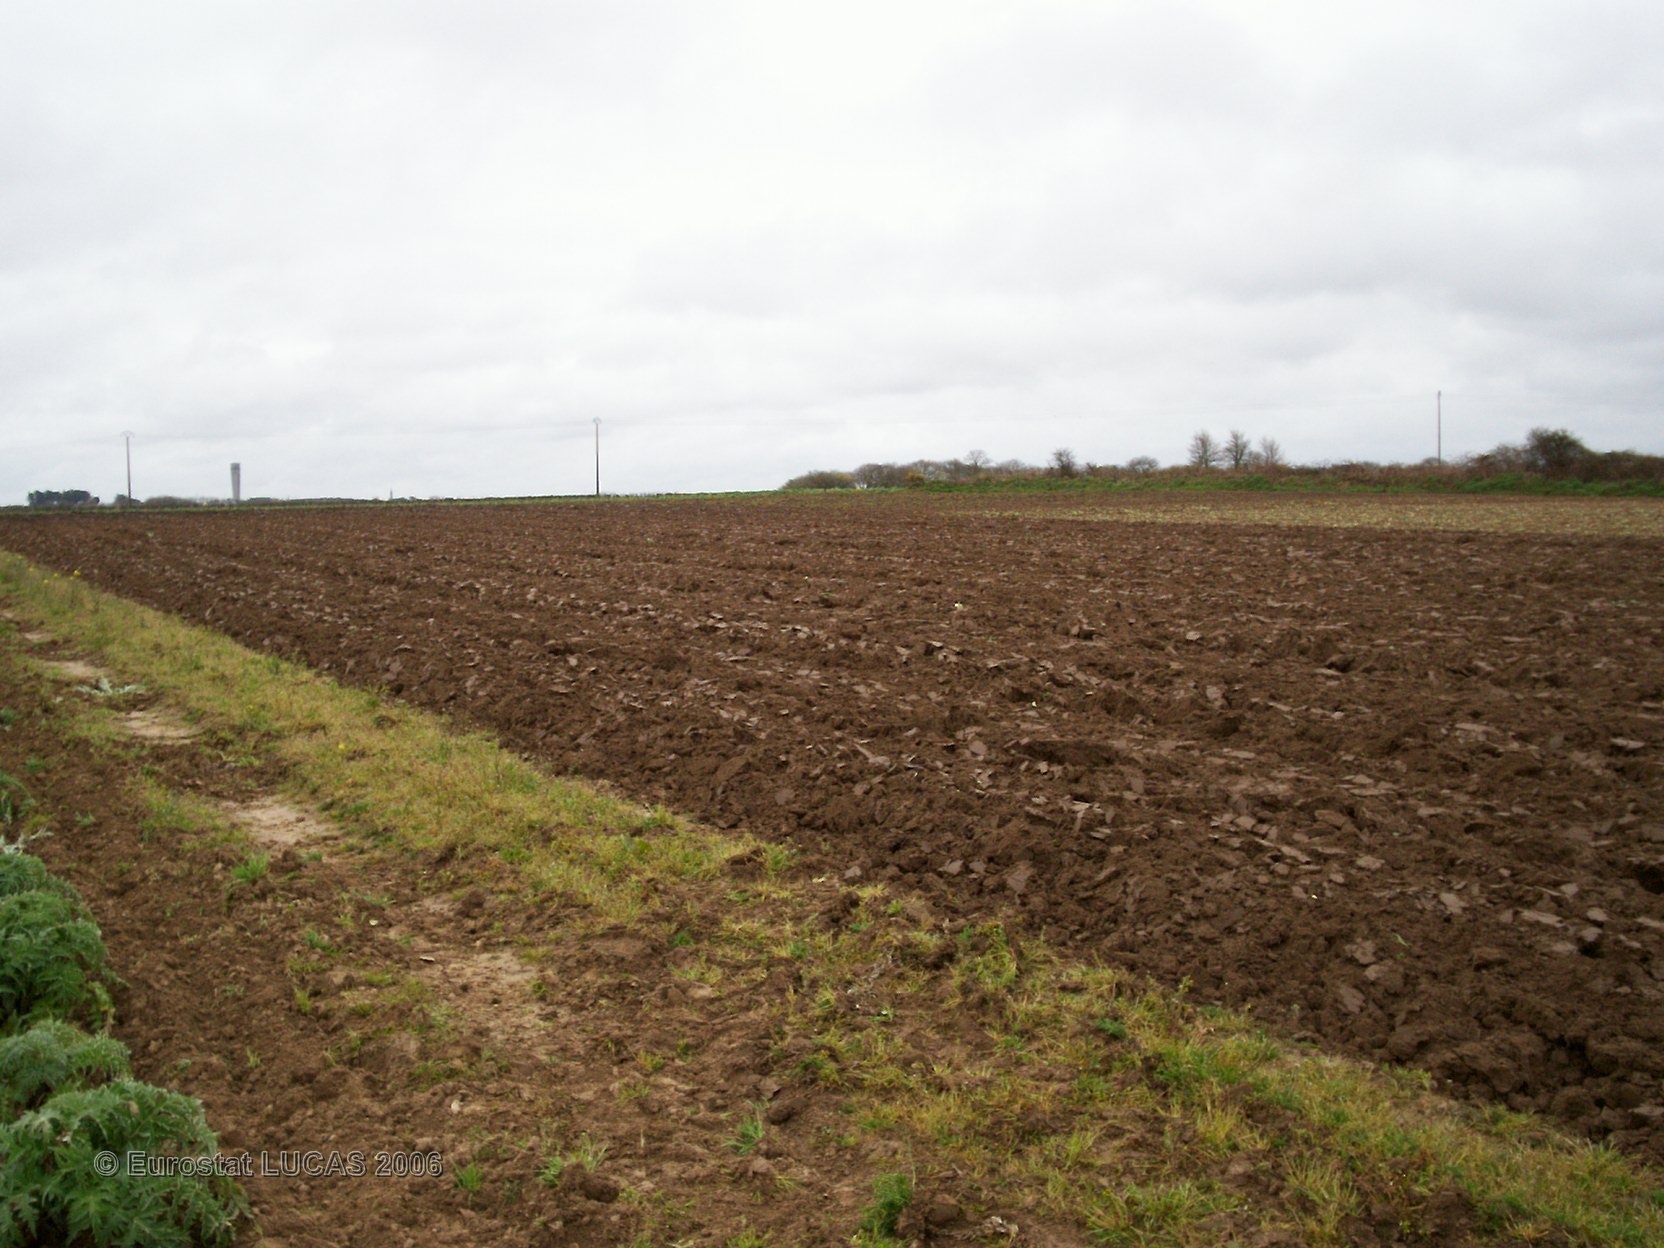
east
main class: Cropland
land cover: Other fresh vegetables
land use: Agriculture (excluding fallow land and kitchen gardens)
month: April
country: FR
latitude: 48.6326
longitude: -4.0529
